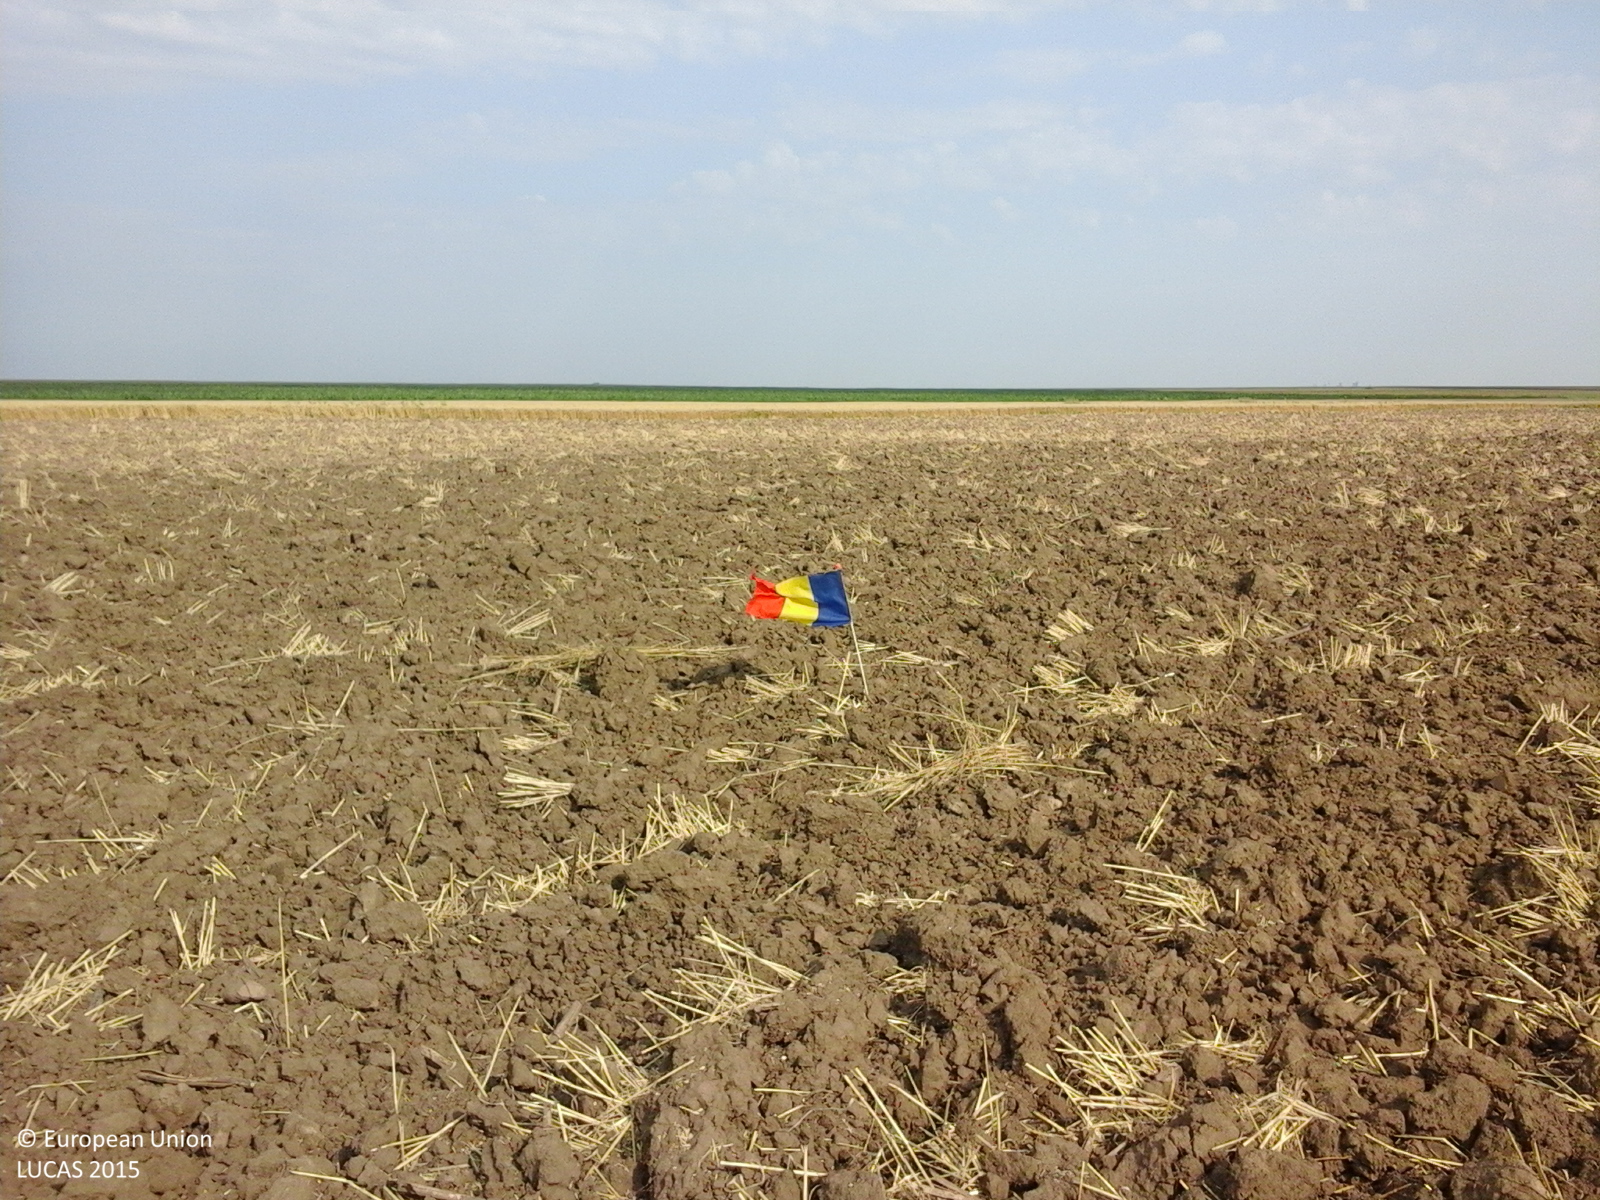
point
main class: Cropland
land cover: Durum wheat
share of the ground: < 10 %
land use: Agriculture (excluding fallow land and kitchen gardens)
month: July
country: RO
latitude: 44.4608
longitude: 27.4479
